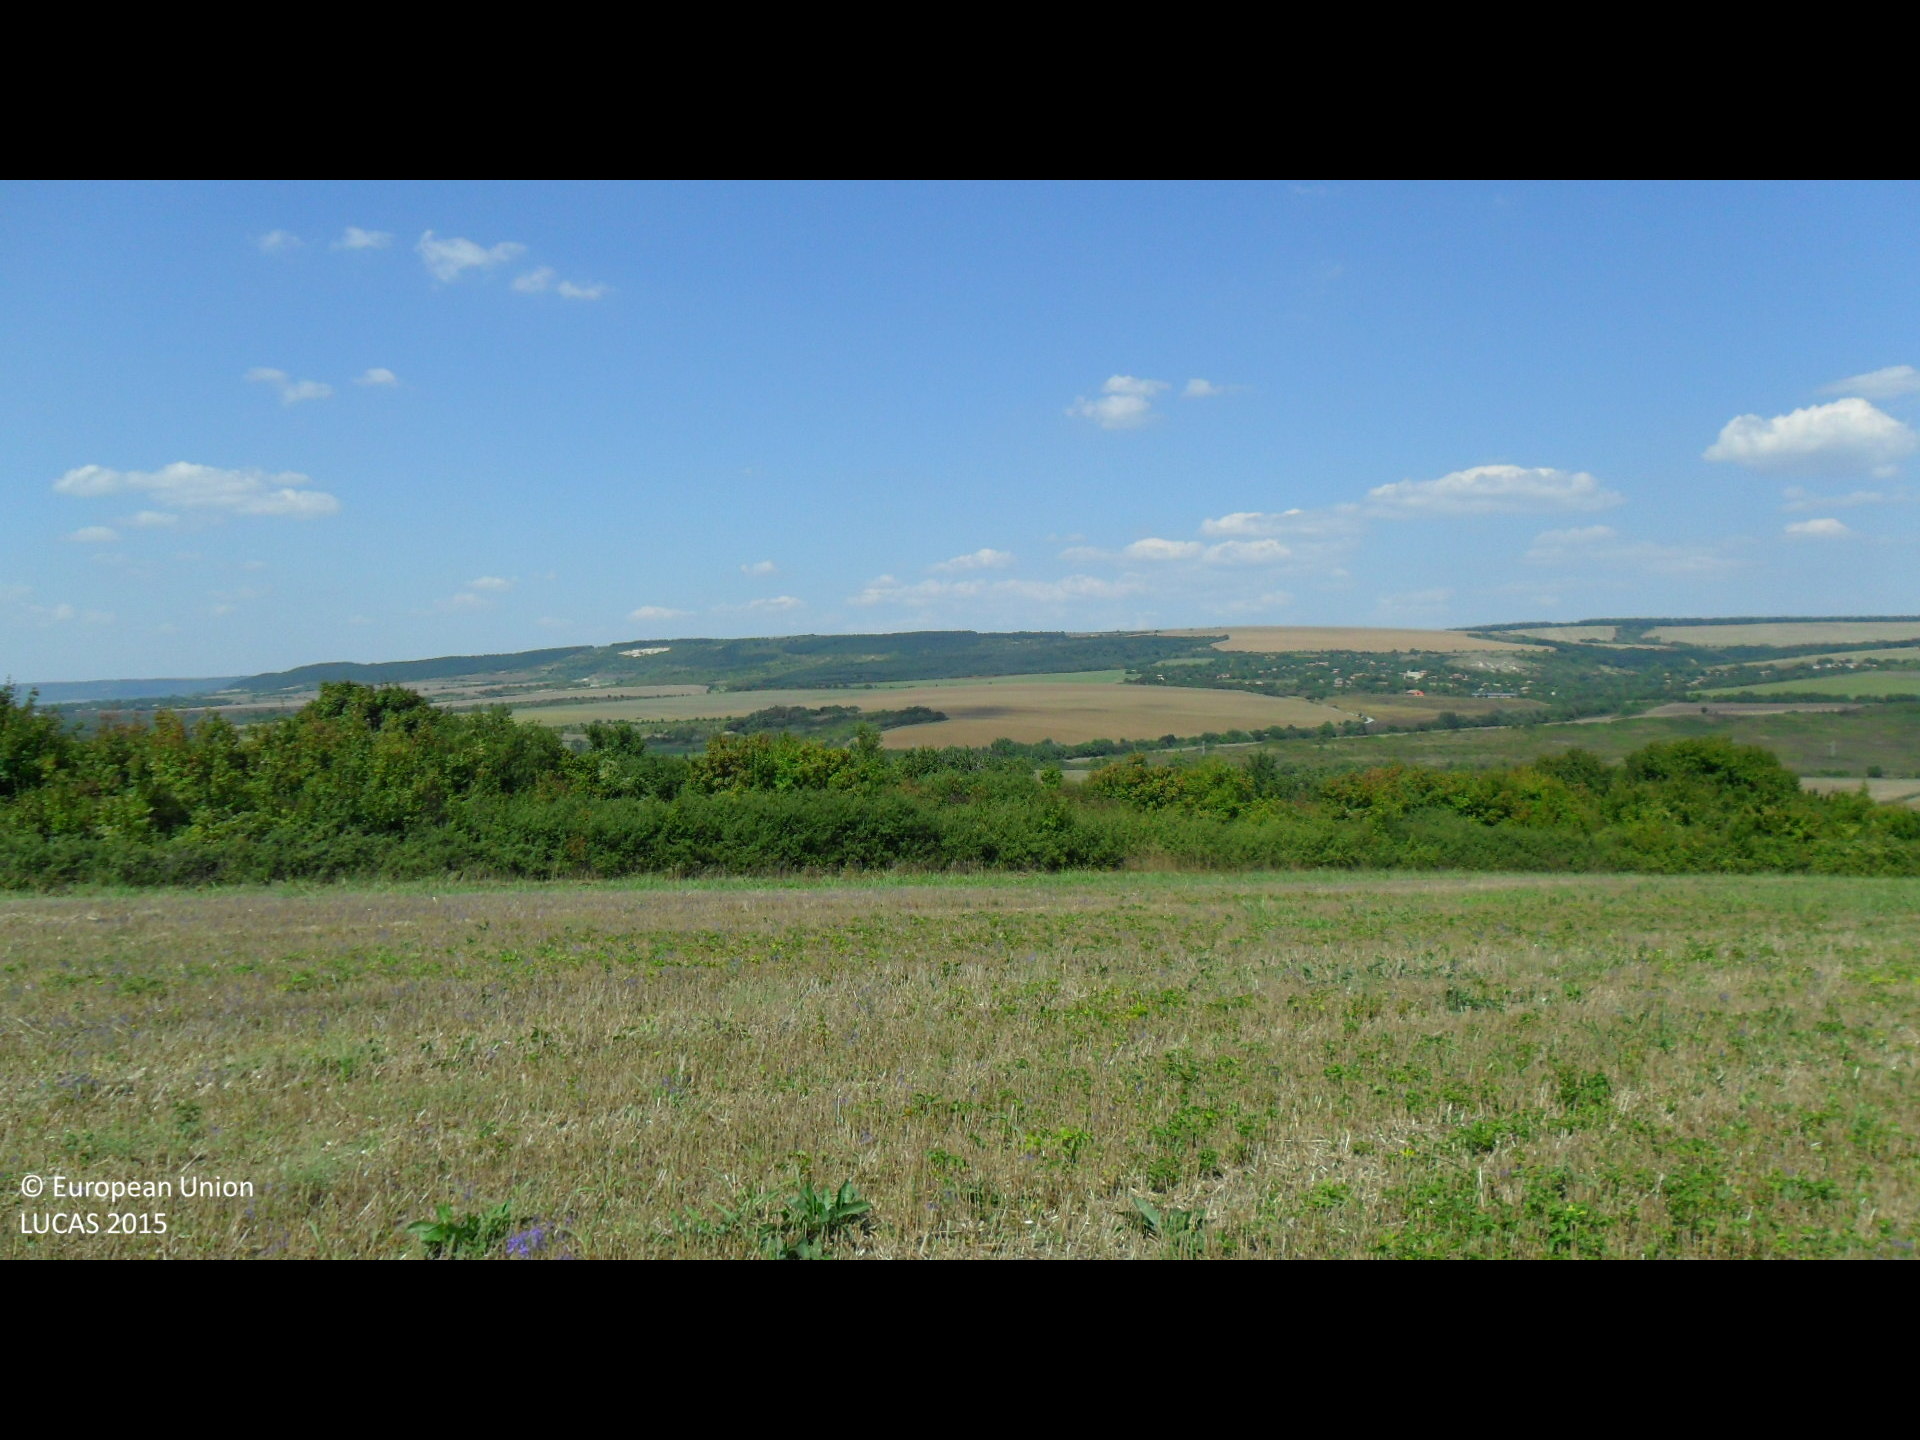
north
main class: Cropland
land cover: Barley
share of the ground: 50 - 75 %
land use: Agriculture (excluding fallow land and kitchen gardens)
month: August
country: BG
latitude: 43.4513
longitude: 26.3253
